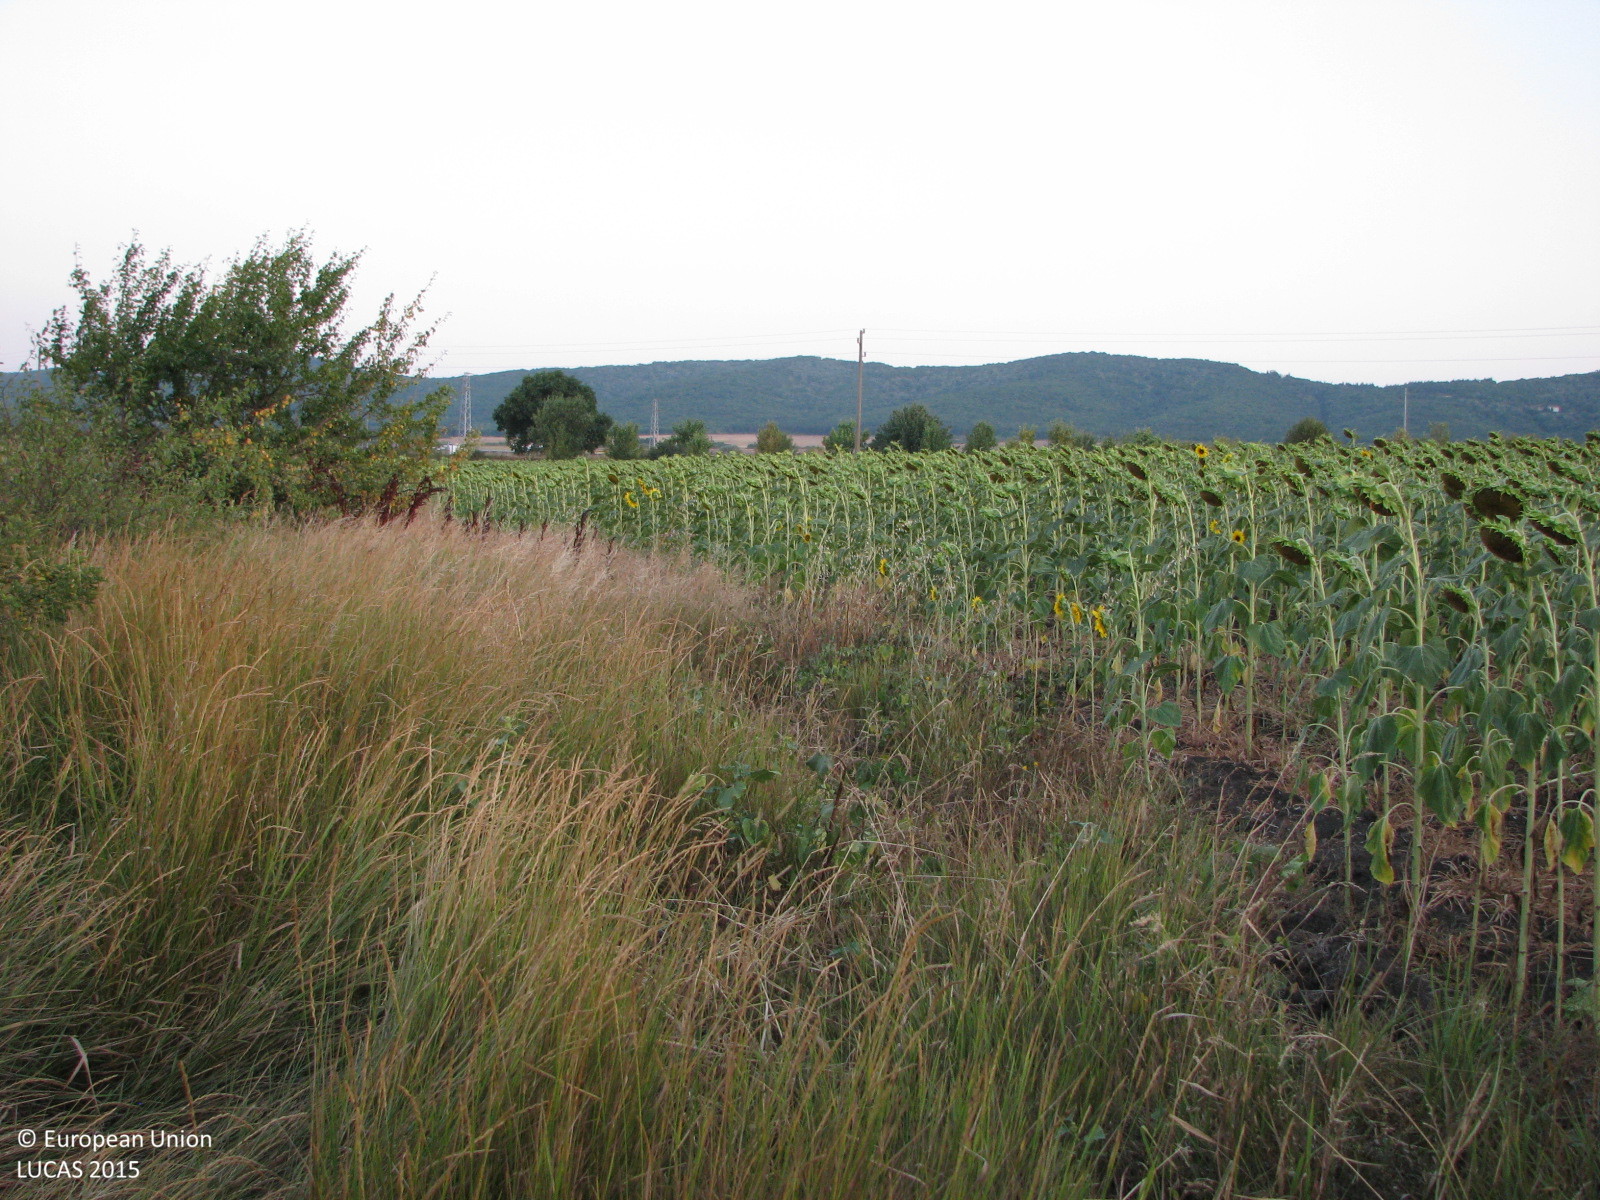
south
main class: Grassland
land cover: Grassland with sparse tree/shrub cover
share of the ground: > 75 %
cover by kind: herbaceous plants 90 %, broadleaved forest trees 5 %, shrubs 5 %
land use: Semi-natural and natural areas not in use
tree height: > 5 m
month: August
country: BG
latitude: 42.4786
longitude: 26.6514
